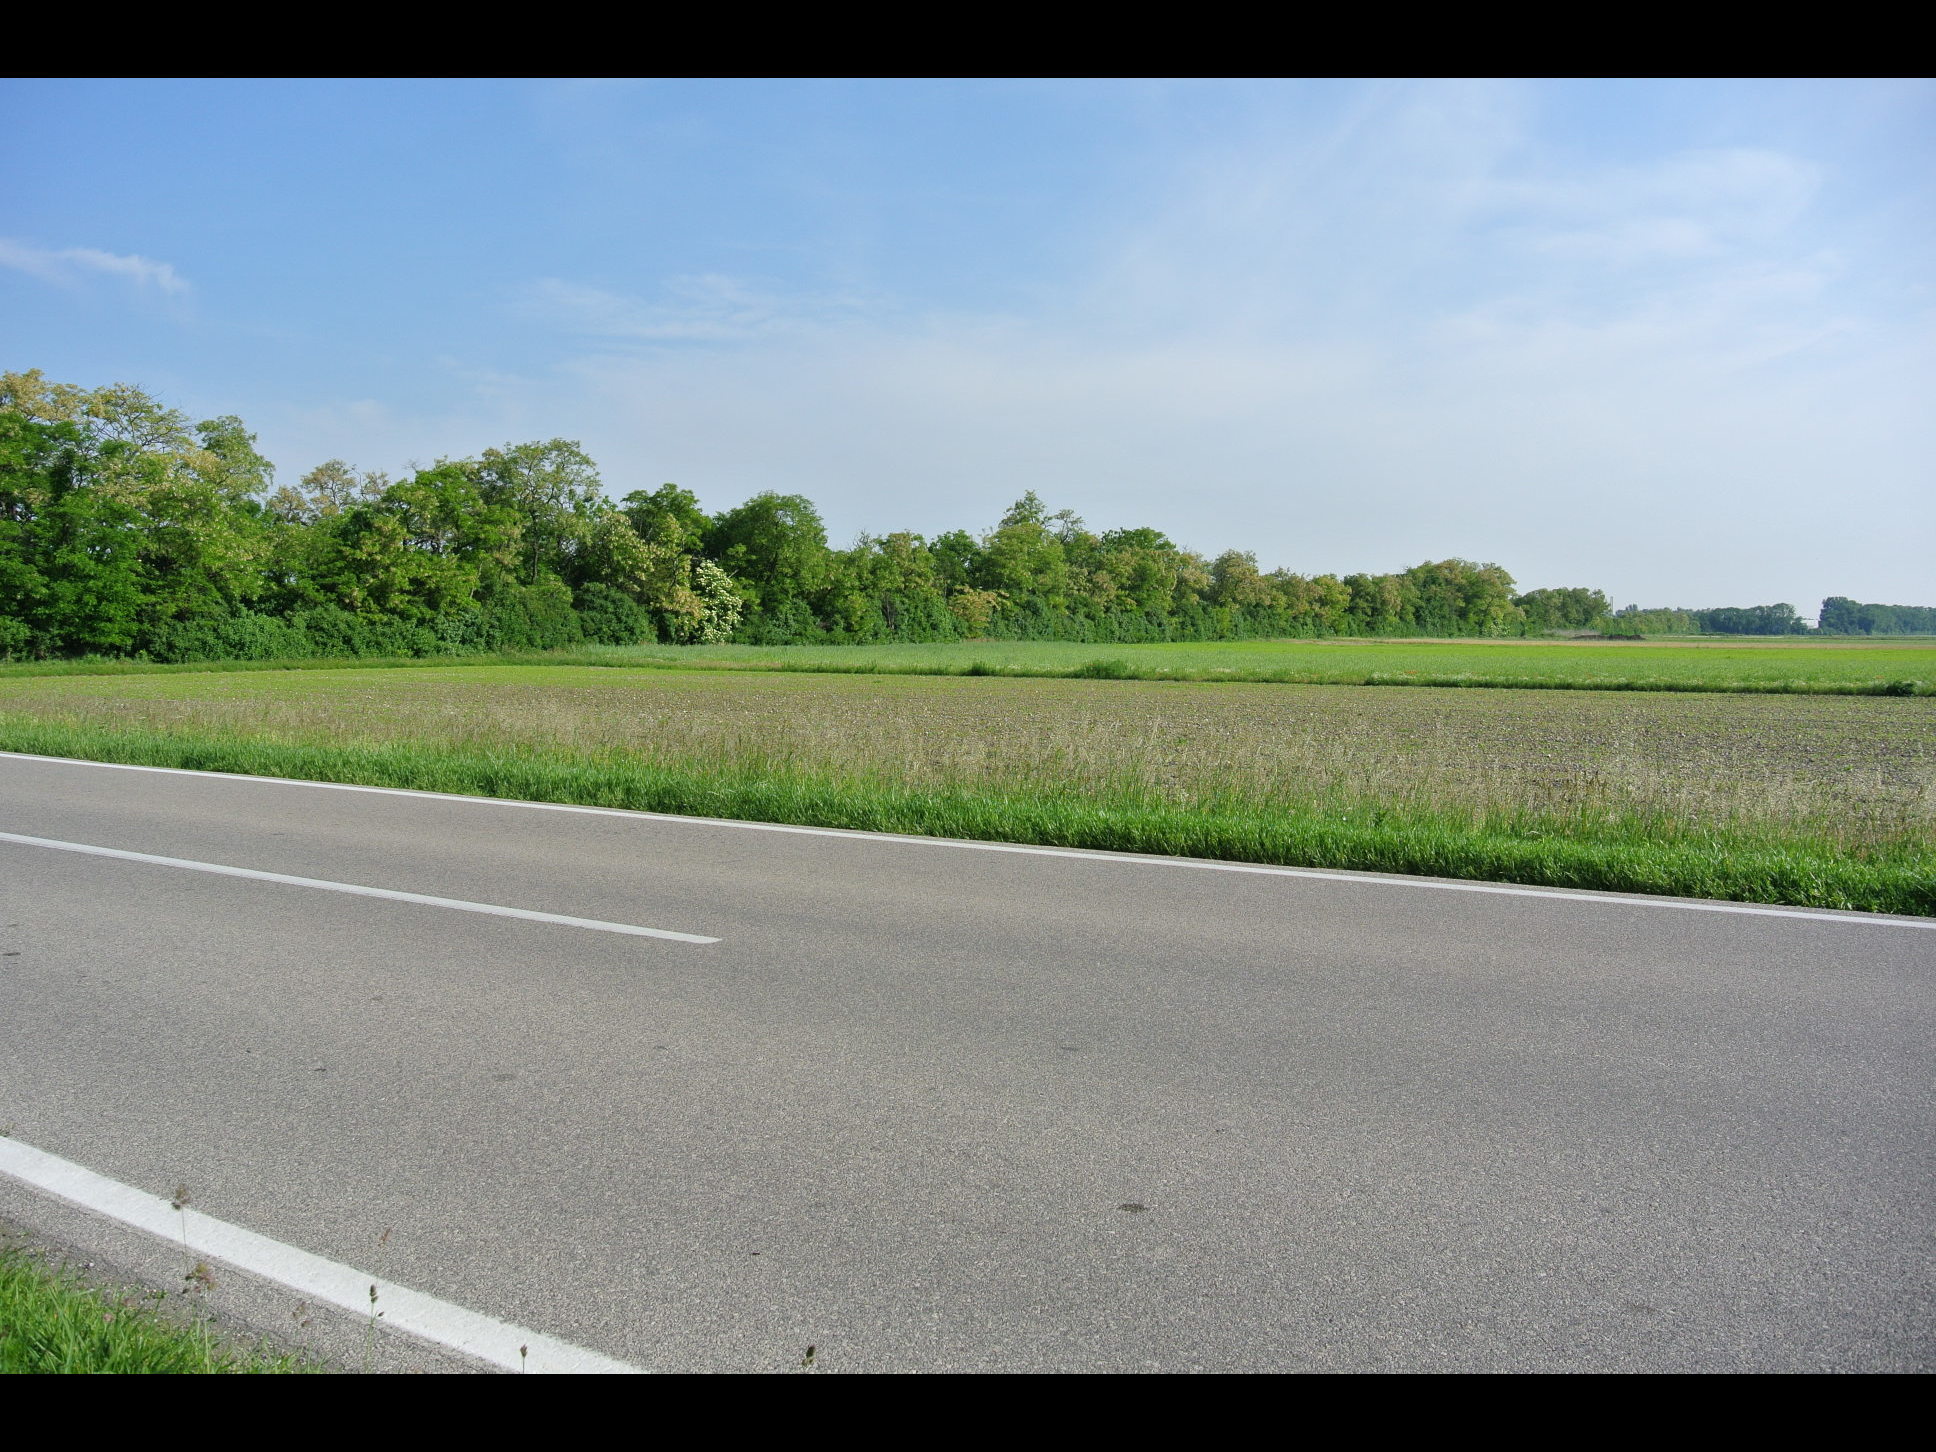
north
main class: Cropland
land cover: Common wheat
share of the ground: > 75 %
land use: Agriculture (excluding fallow land and kitchen gardens)
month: May
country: AT
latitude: 47.9595
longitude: 16.5001
